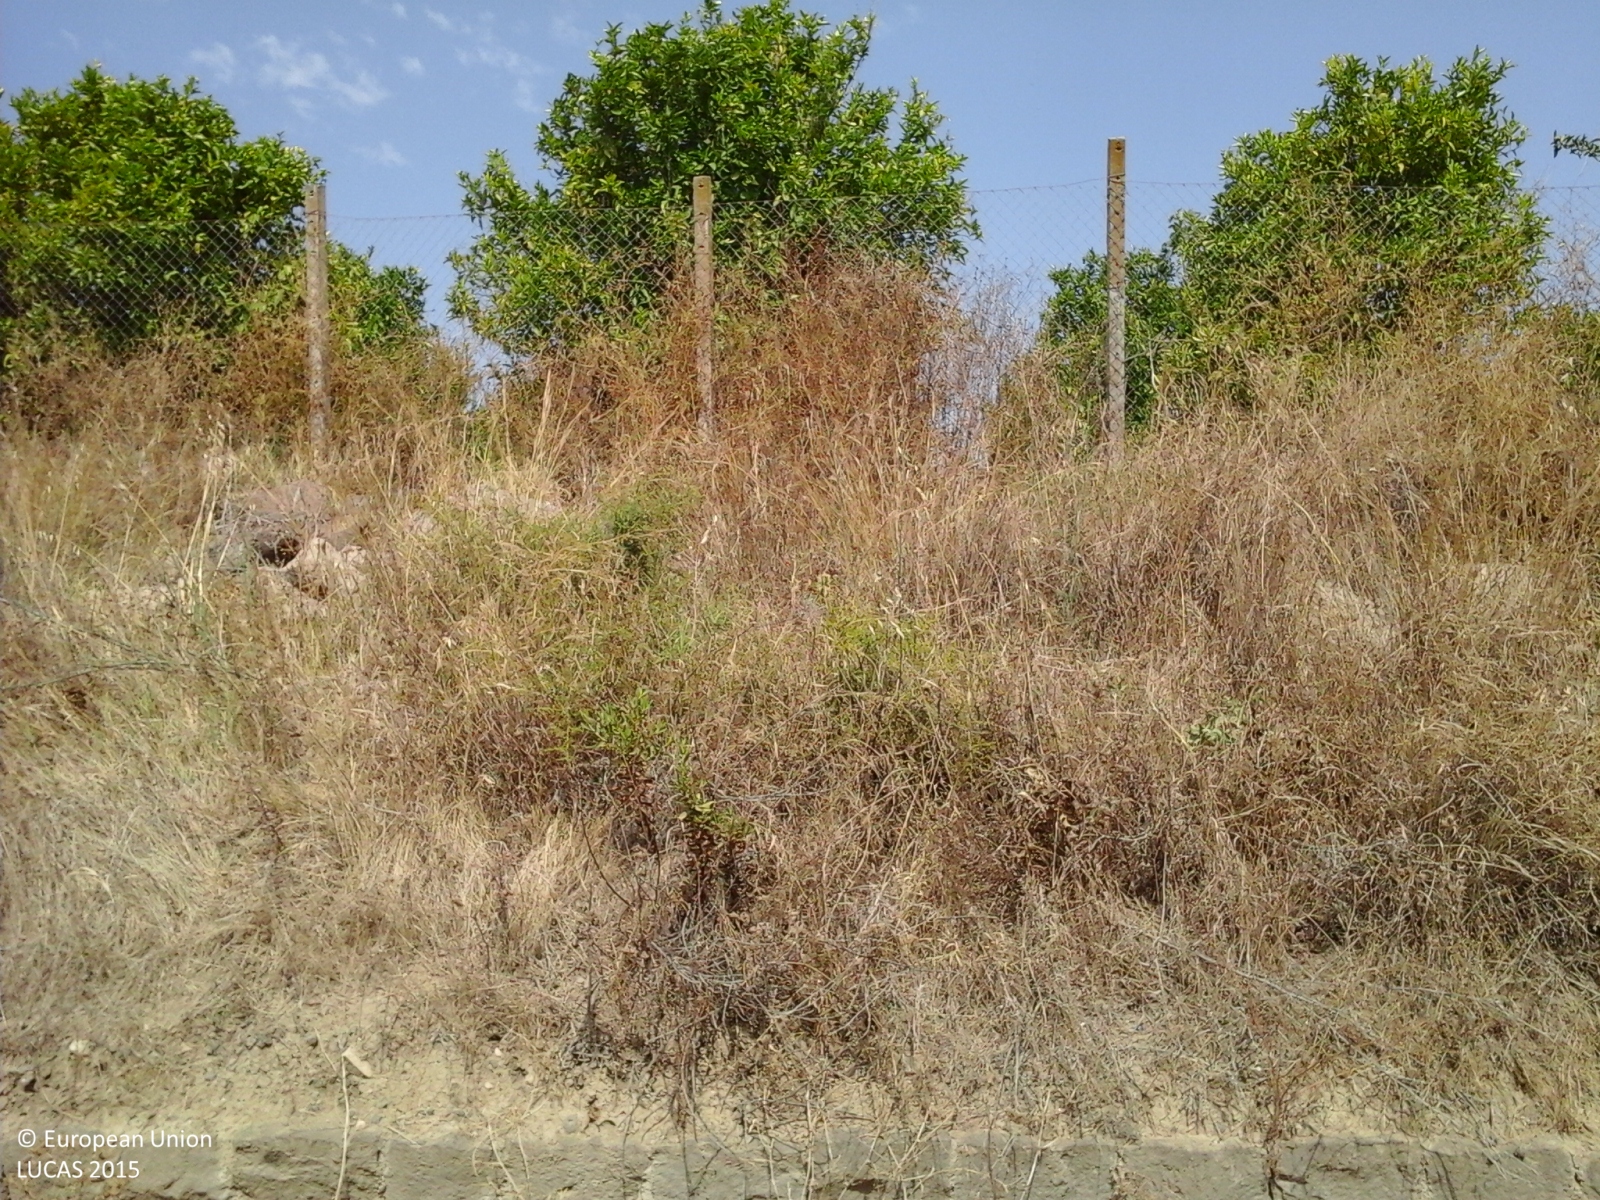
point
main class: Cropland
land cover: Oranges
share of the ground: > 75 %
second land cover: Spontaneously vegetated surfaces
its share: > 75 %
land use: Agriculture (excluding fallow land and kitchen gardens)
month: August
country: IT
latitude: 37.2784
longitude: 14.8471
